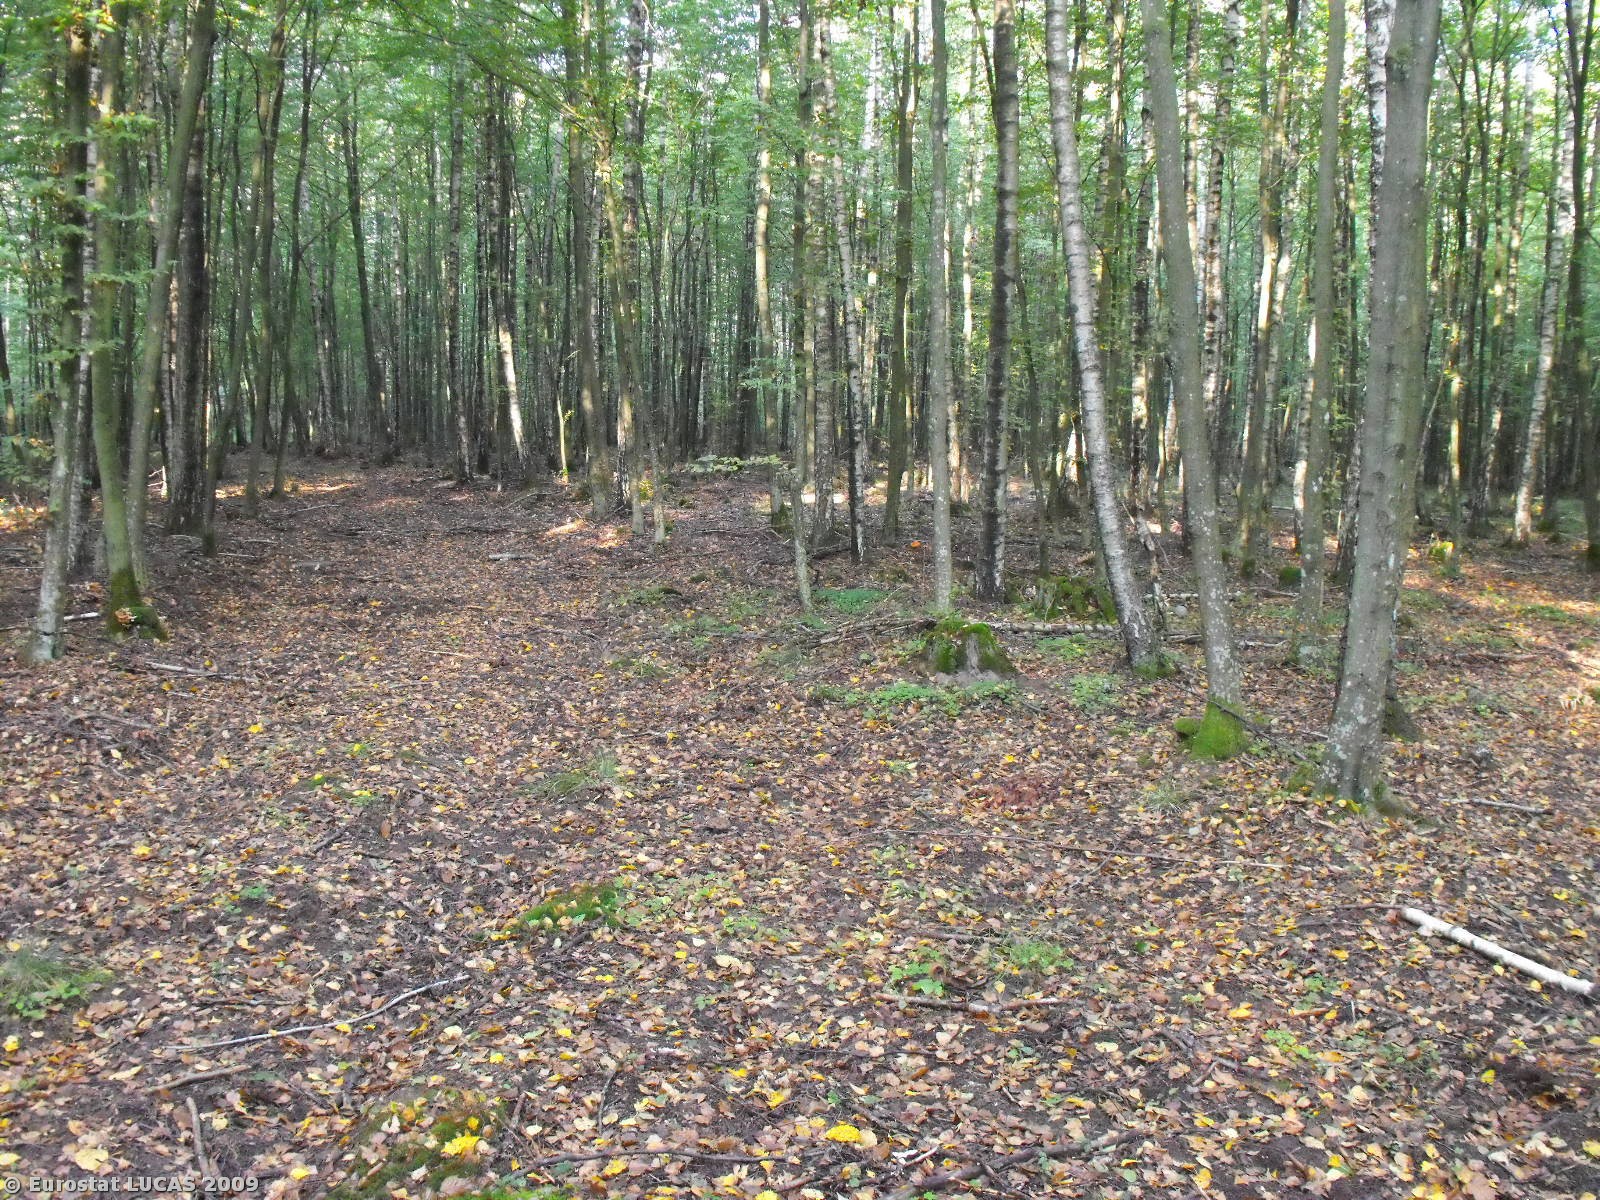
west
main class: Woodland
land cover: Broadleaved woodland
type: hemiboreal forest and nemoral coniferous forest and mixed broadleaved-coniferous forest
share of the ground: > 75 %
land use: Forestry
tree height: > 5 m
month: September
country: PL
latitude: 54.3920
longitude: 16.6441
